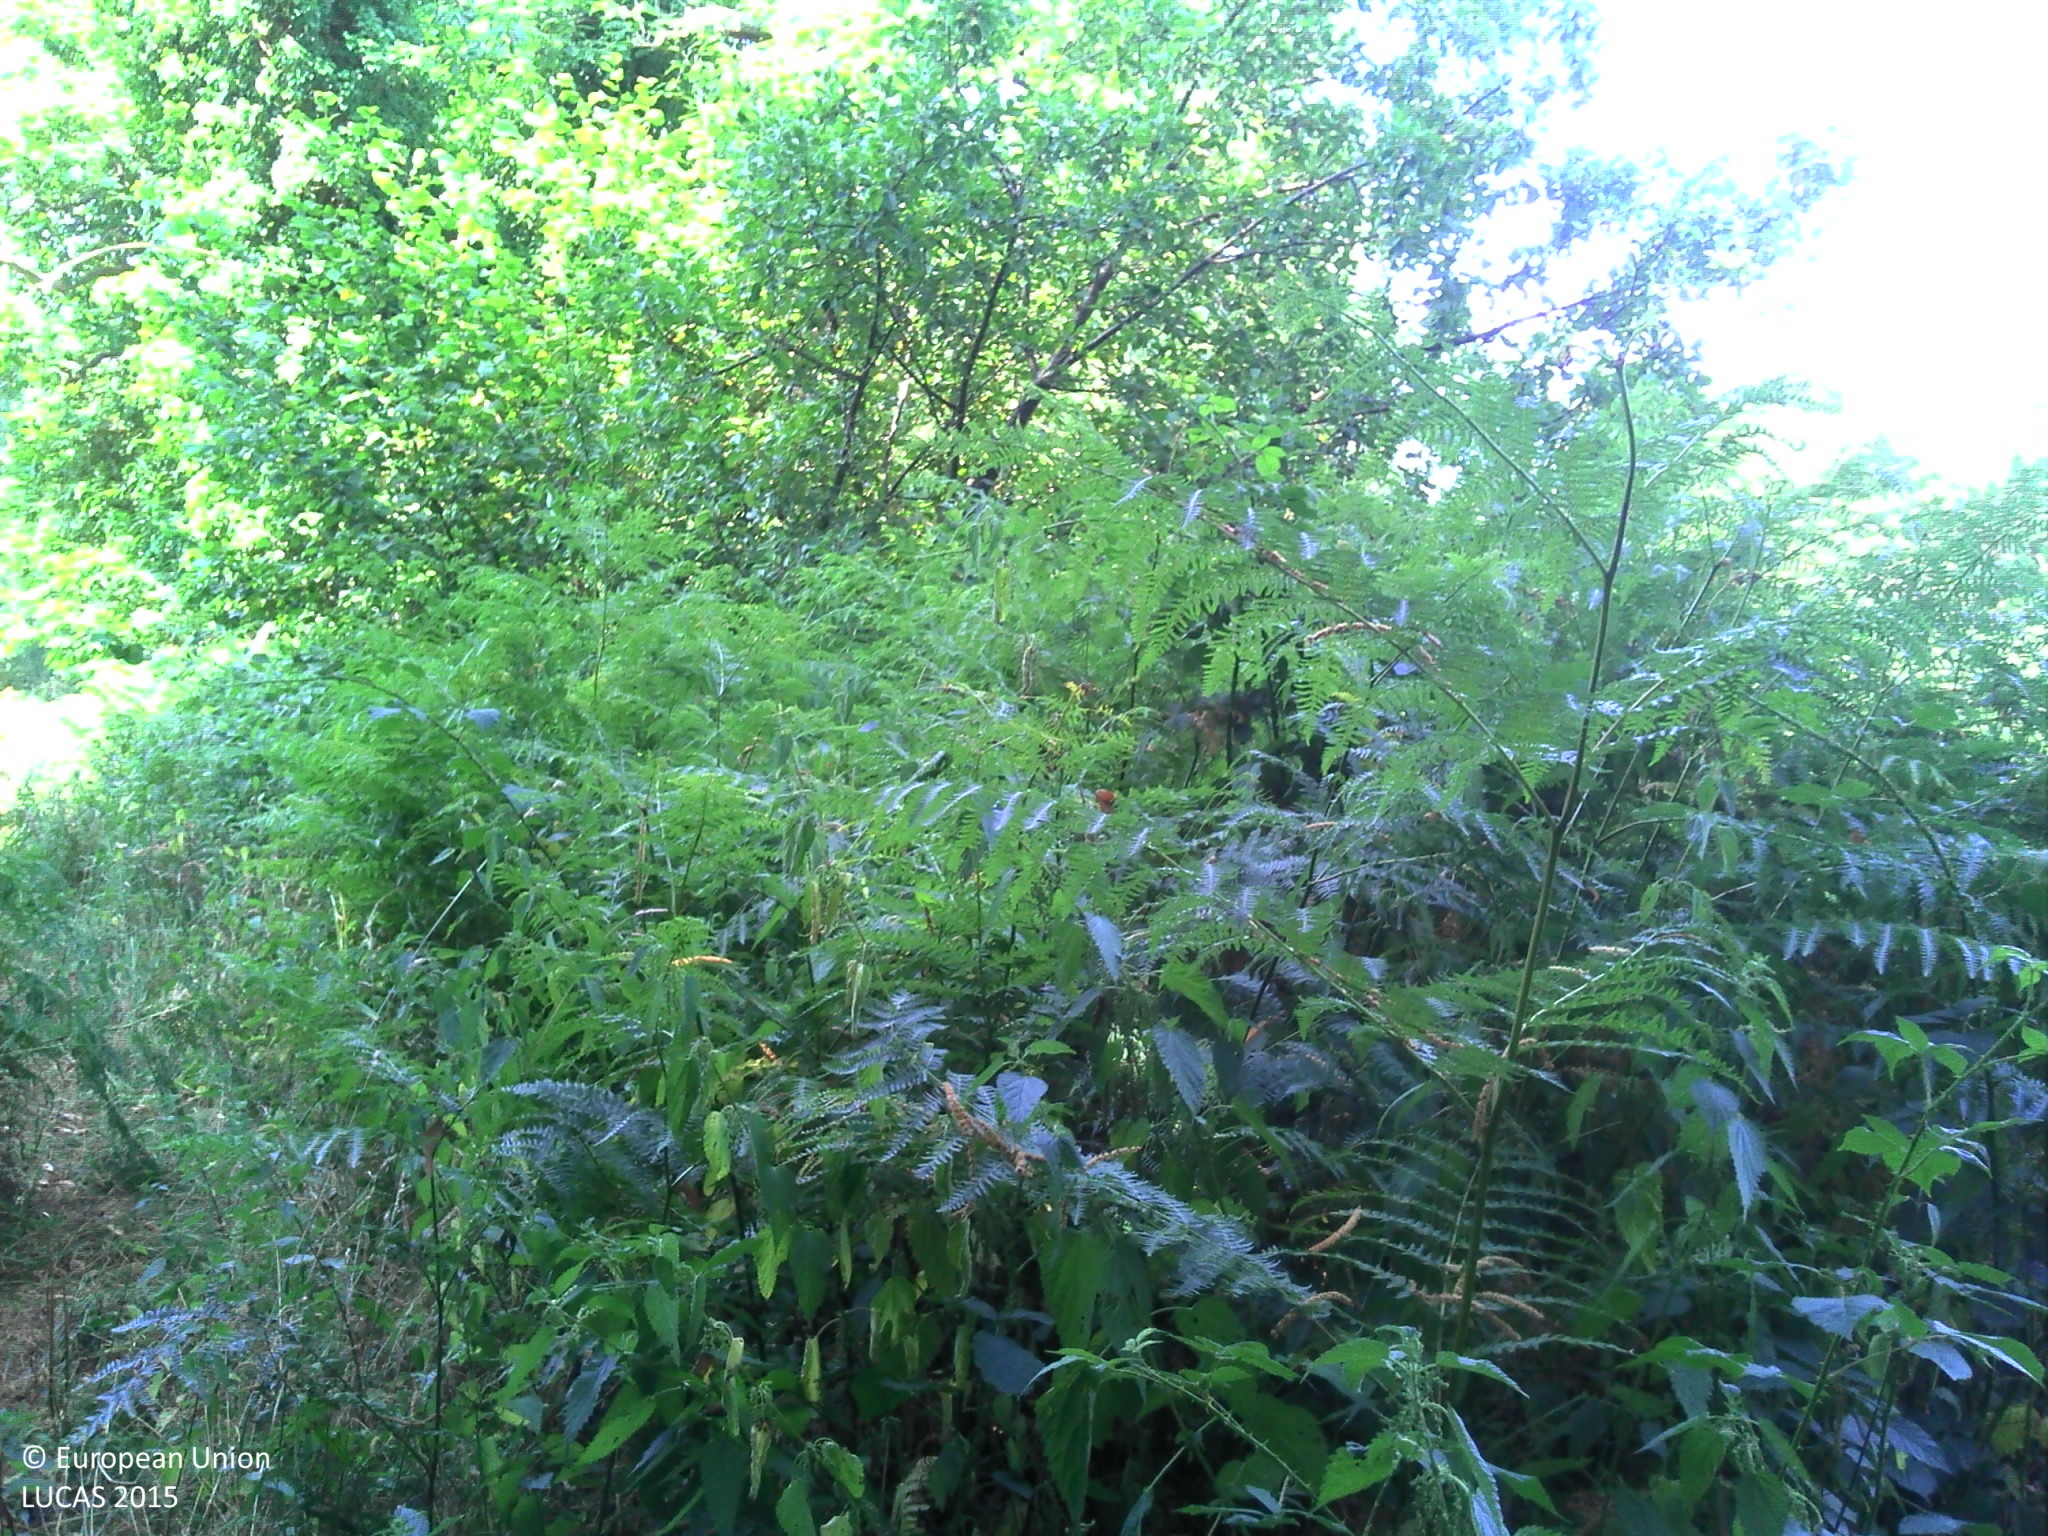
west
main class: Woodland
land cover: Broadleaved woodland
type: mesophytic deciduous forest
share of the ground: 50 - 75 %
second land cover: Spontaneously vegetated surfaces
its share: > 75 %
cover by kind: broadleaved forest trees 60 %, shrubs 30 %, herbaceous plants 10 %
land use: Forestry
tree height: > 5 m
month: July
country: FR
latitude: 47.7078
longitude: 0.3404
